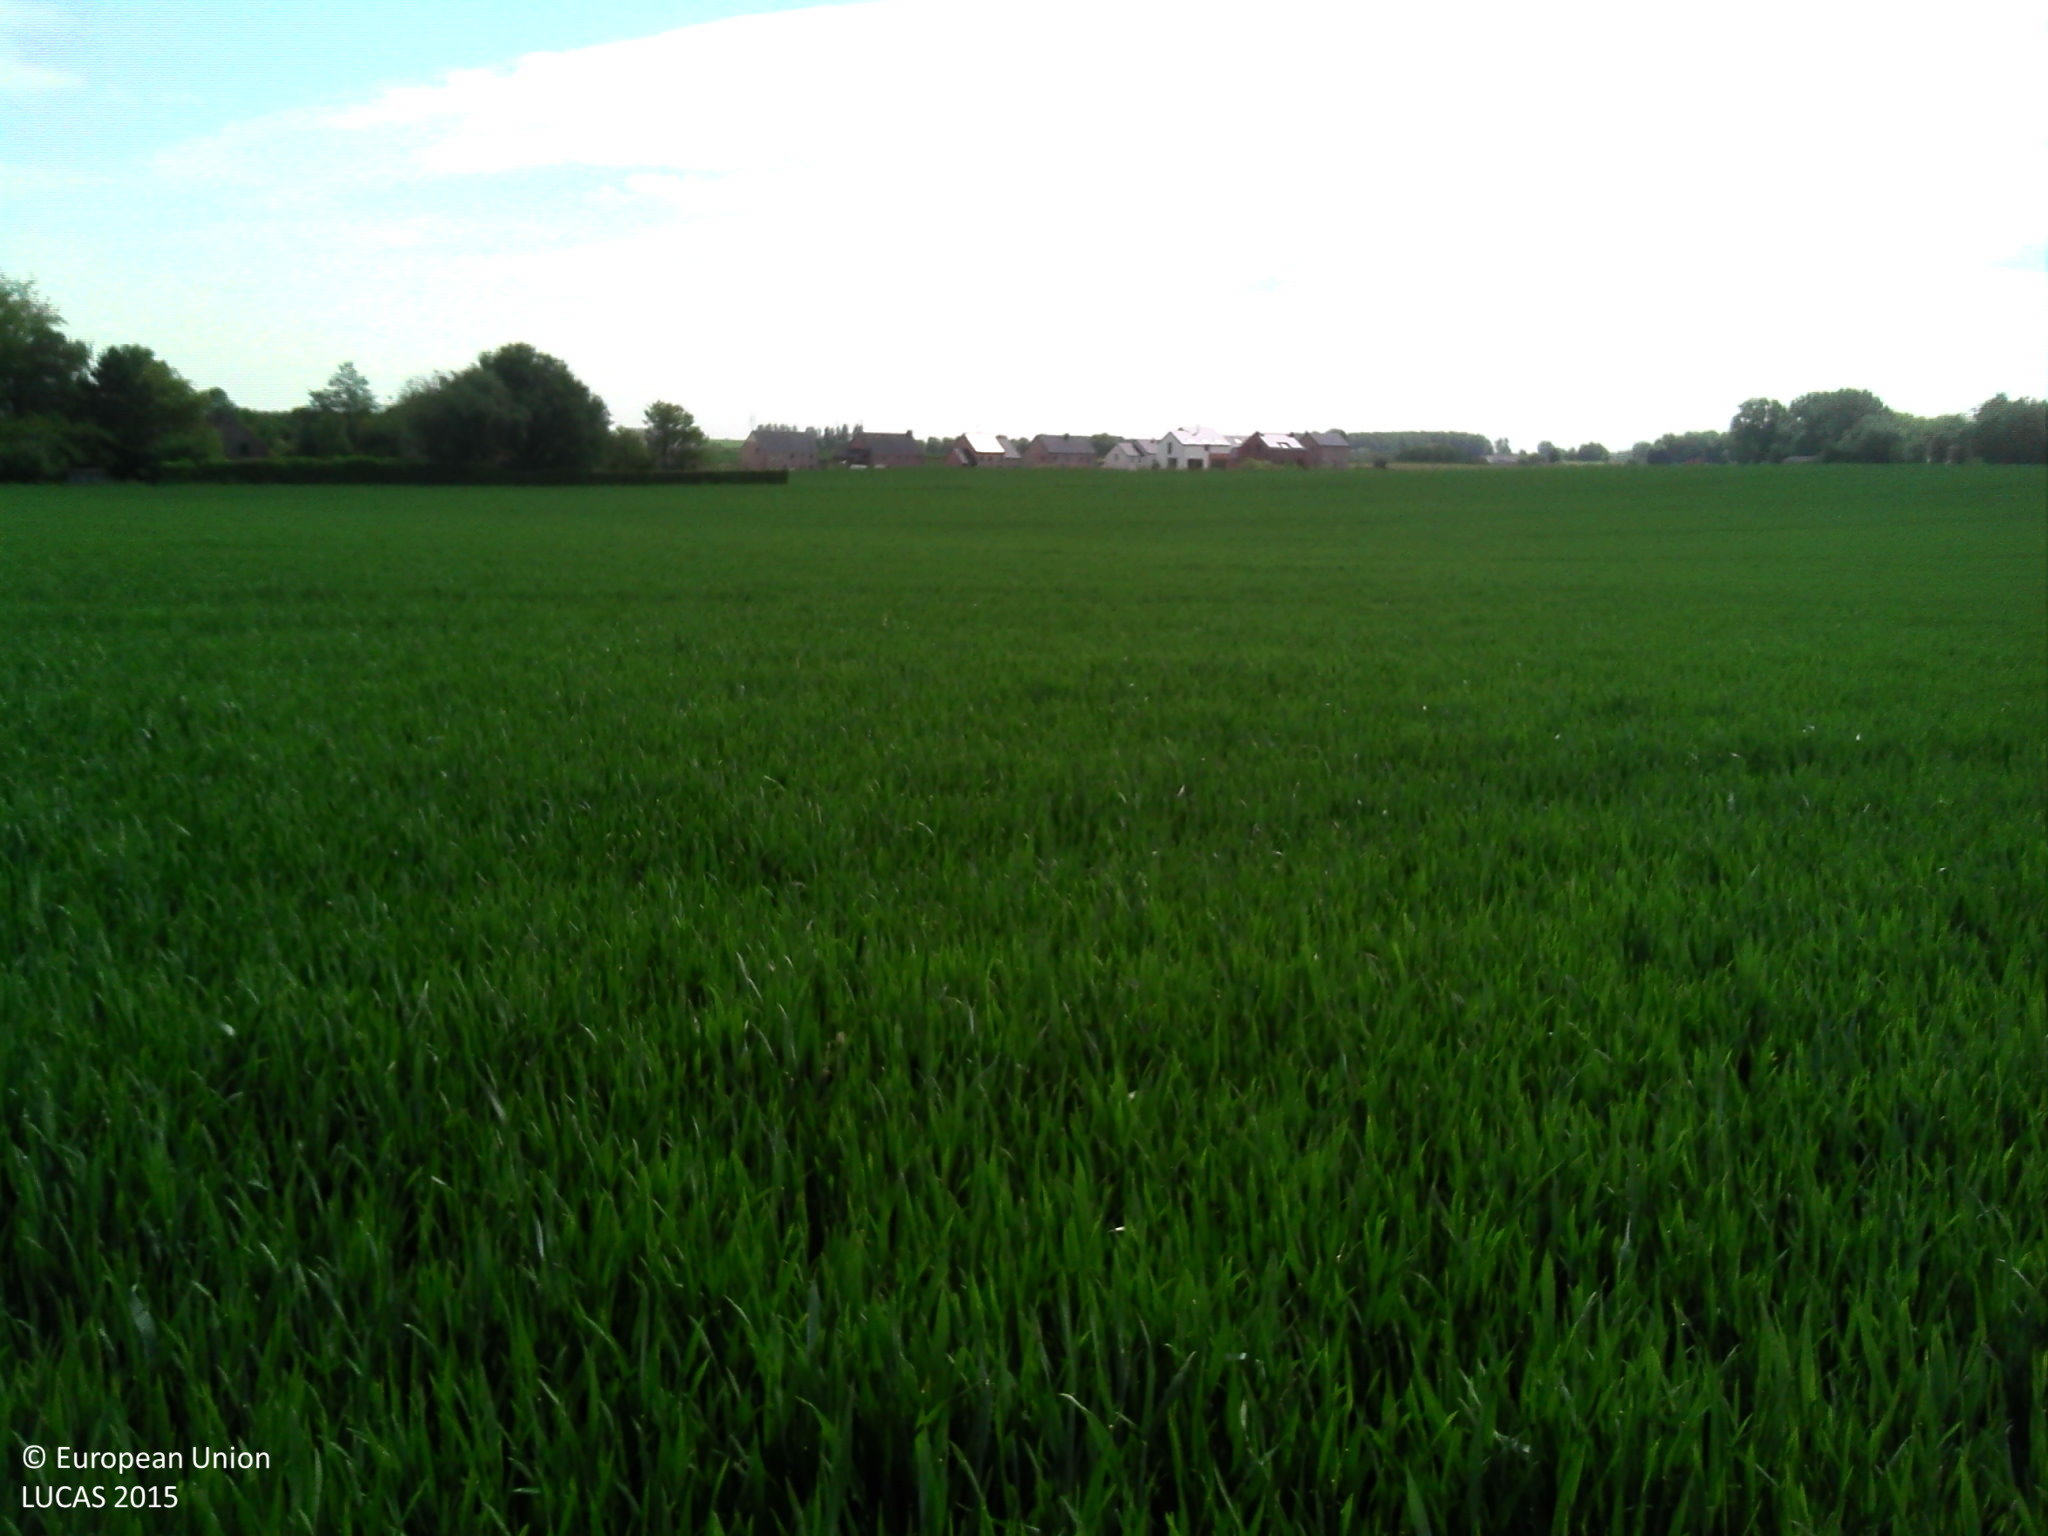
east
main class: Cropland
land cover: Common wheat
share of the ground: > 75 %
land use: Agriculture (excluding fallow land and kitchen gardens)
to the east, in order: Common wheat
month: May
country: BE
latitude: 50.5399
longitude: 4.5353
